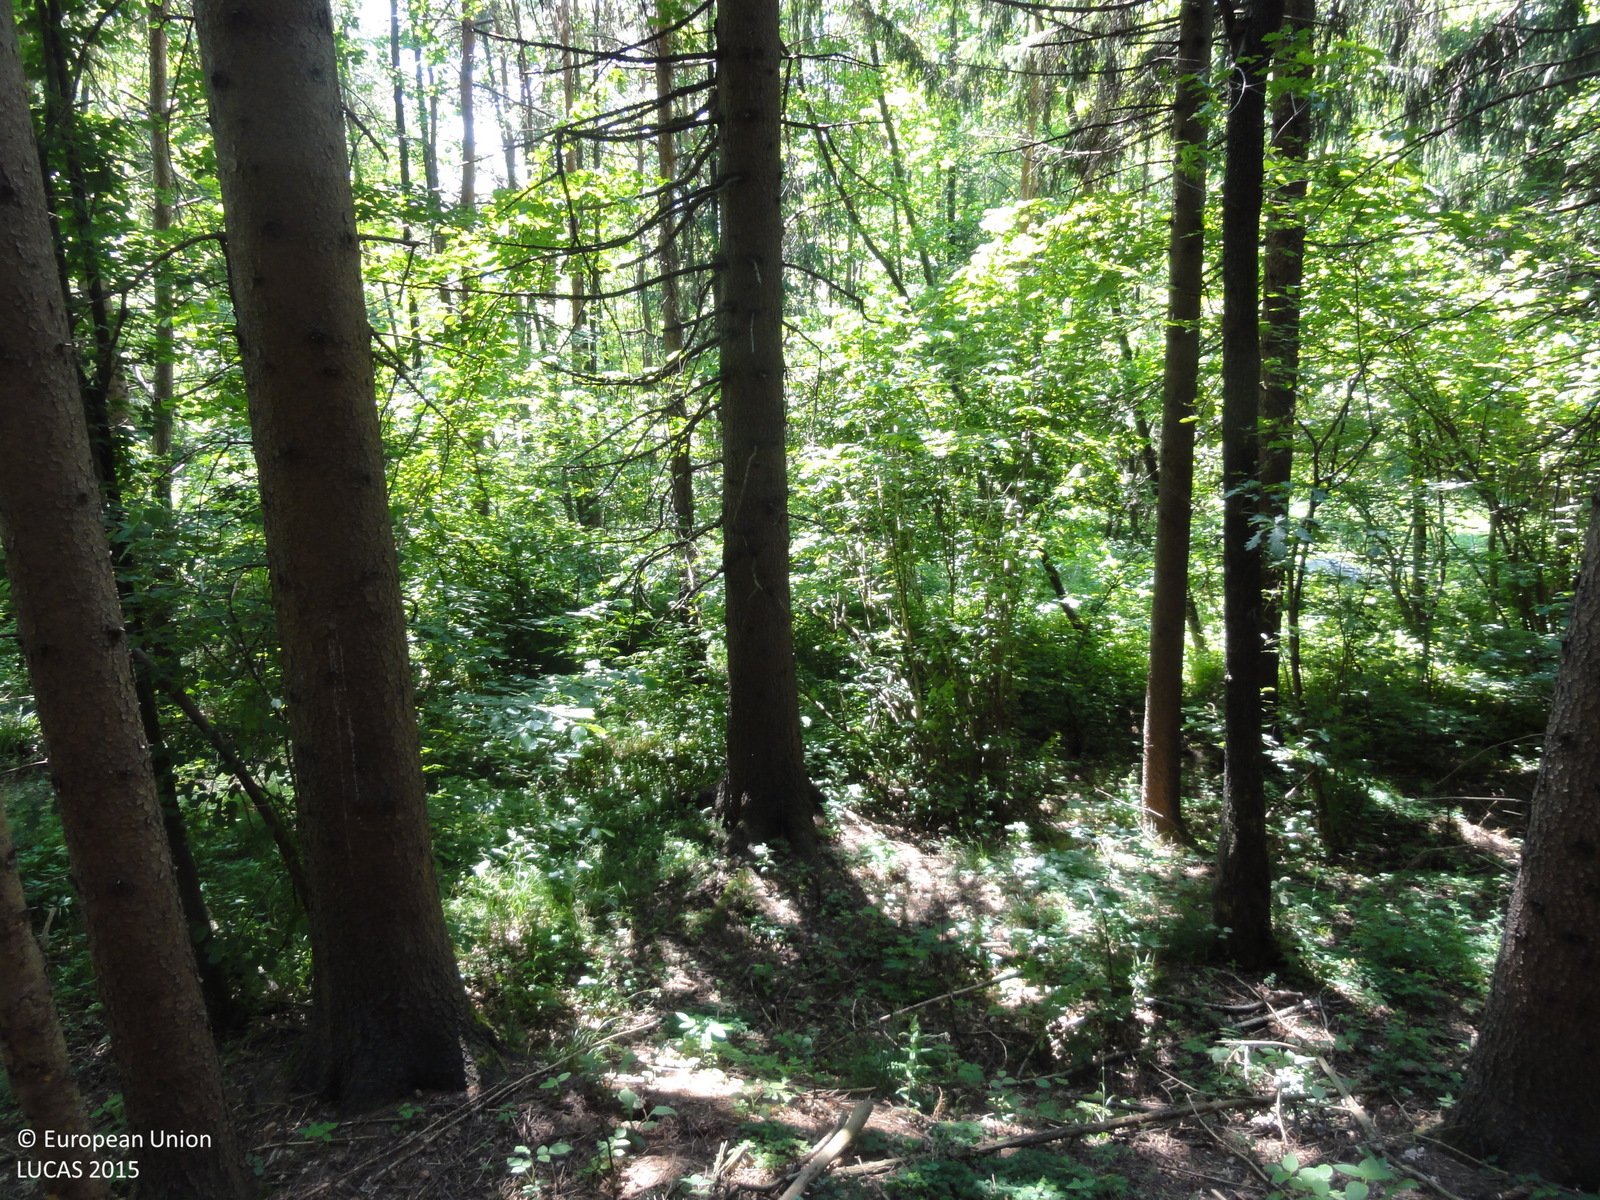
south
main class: Woodland
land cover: Spruce dominated mixed woodland
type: mesophytic deciduous forest
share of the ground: > 75 %
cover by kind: coniferous forest trees 65 %, broadleaved forest trees 35 %
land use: Forestry
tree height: > 5 m
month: June
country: SI
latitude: 46.3544
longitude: 15.4955
